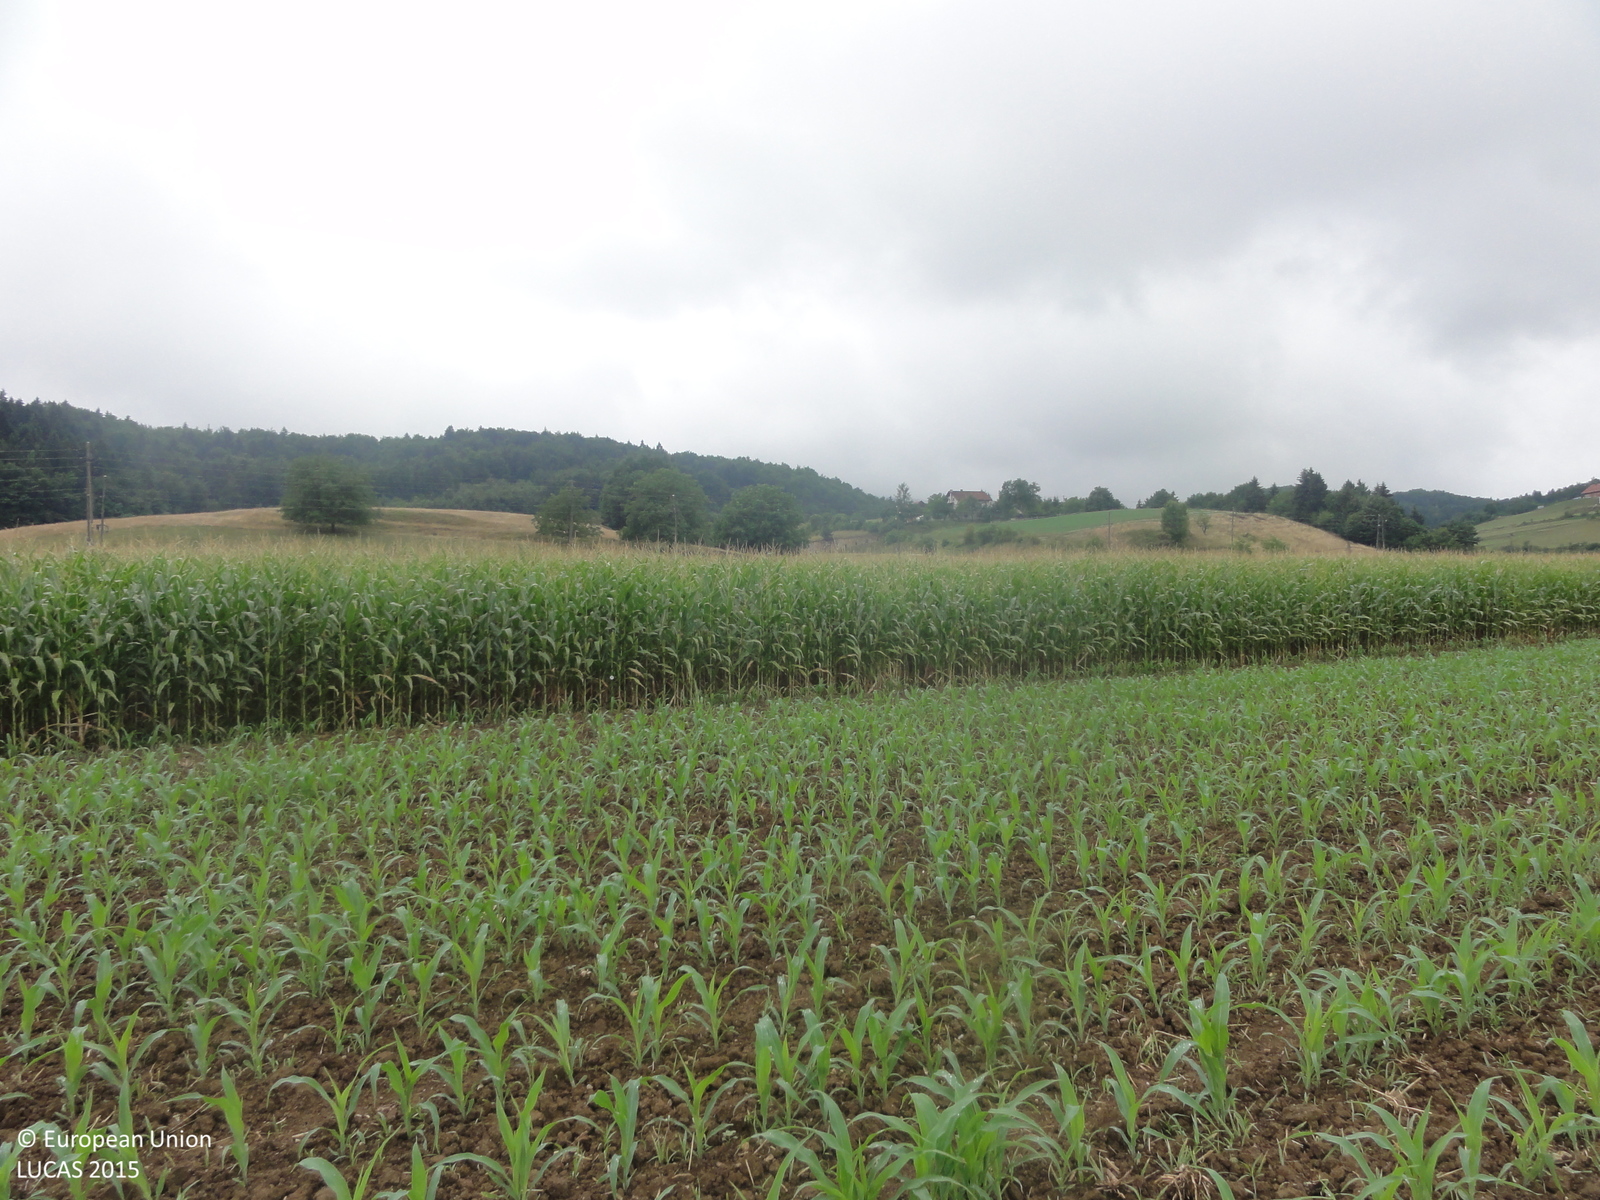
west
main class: Cropland
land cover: Maize
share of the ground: 25 - 50 %
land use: Agriculture (excluding fallow land and kitchen gardens)
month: July
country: SI
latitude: 45.9376
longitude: 14.7816
